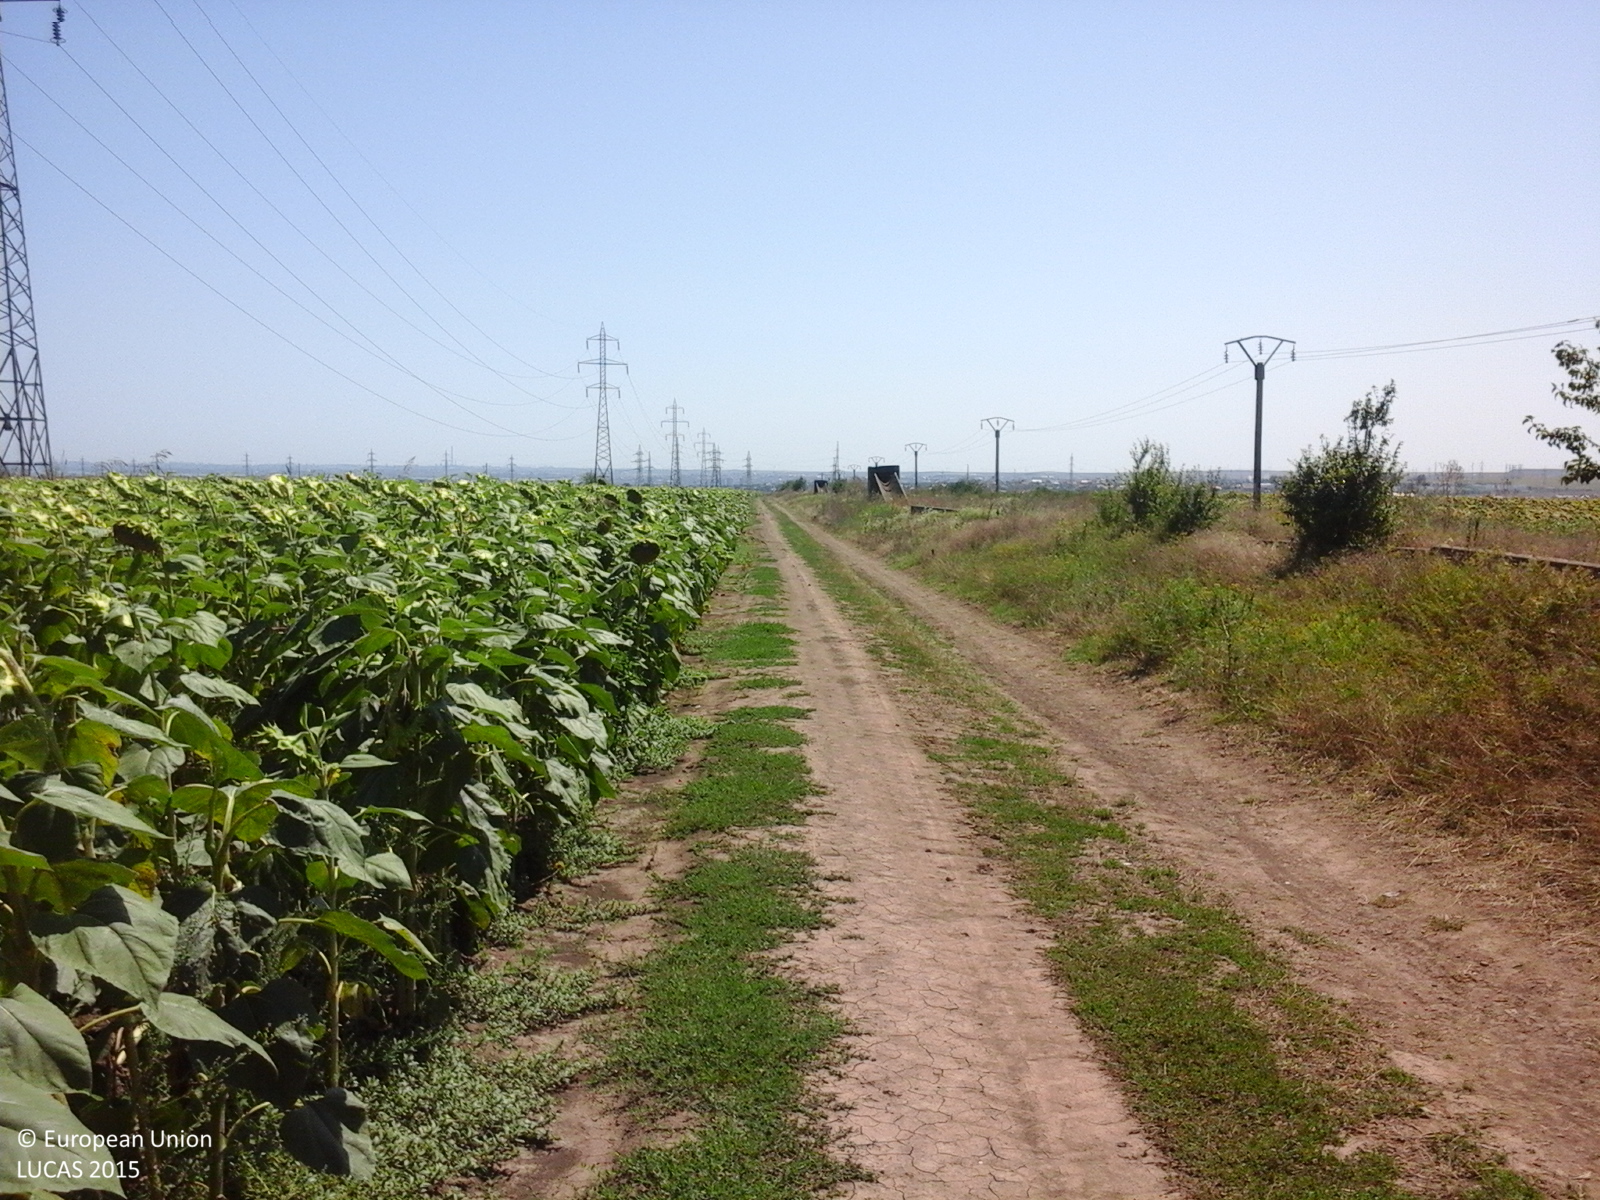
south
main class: Cropland
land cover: Sunflower
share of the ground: > 75 %
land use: Agriculture (excluding fallow land and kitchen gardens)
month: August
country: RO
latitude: 44.3190
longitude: 28.5673
